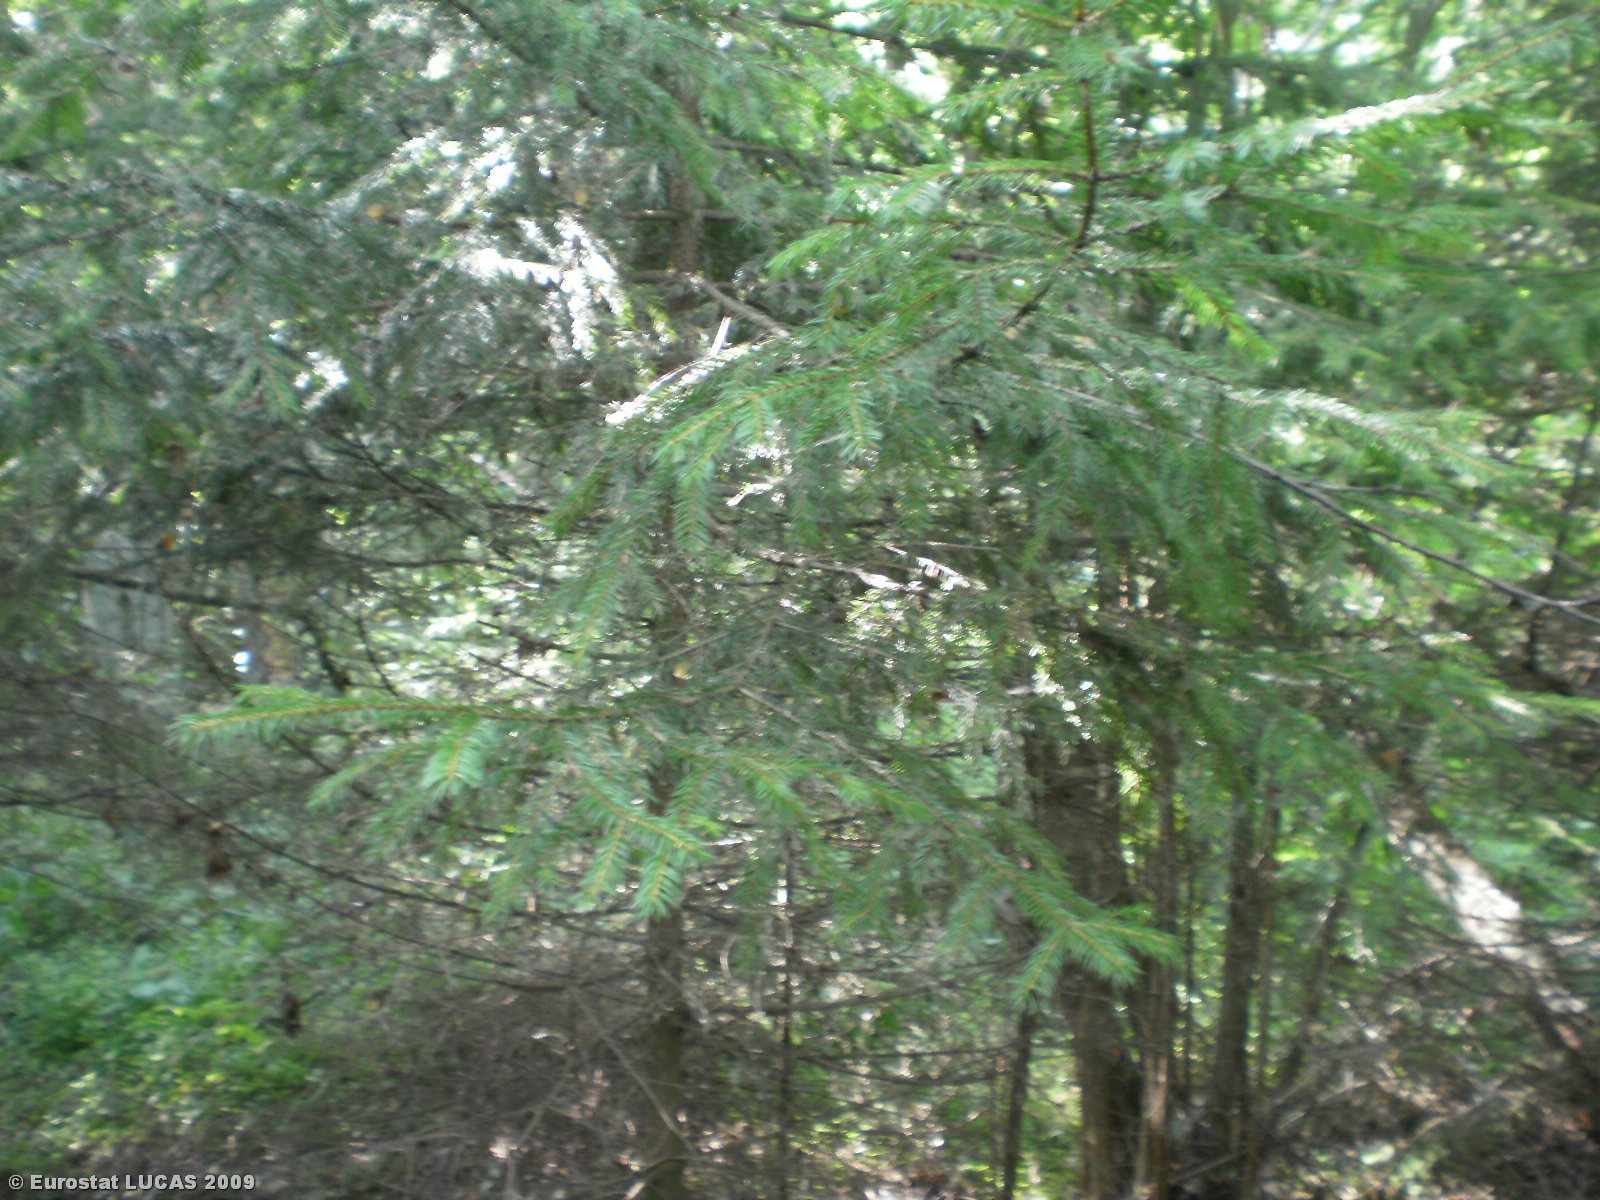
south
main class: Woodland
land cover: Mixed woodland
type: hemiboreal forest and nemoral coniferous forest and mixed broadleaved-coniferous forest
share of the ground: > 75 %
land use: Forestry
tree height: > 5 m
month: August
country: LT
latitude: 55.1174
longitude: 24.8315
